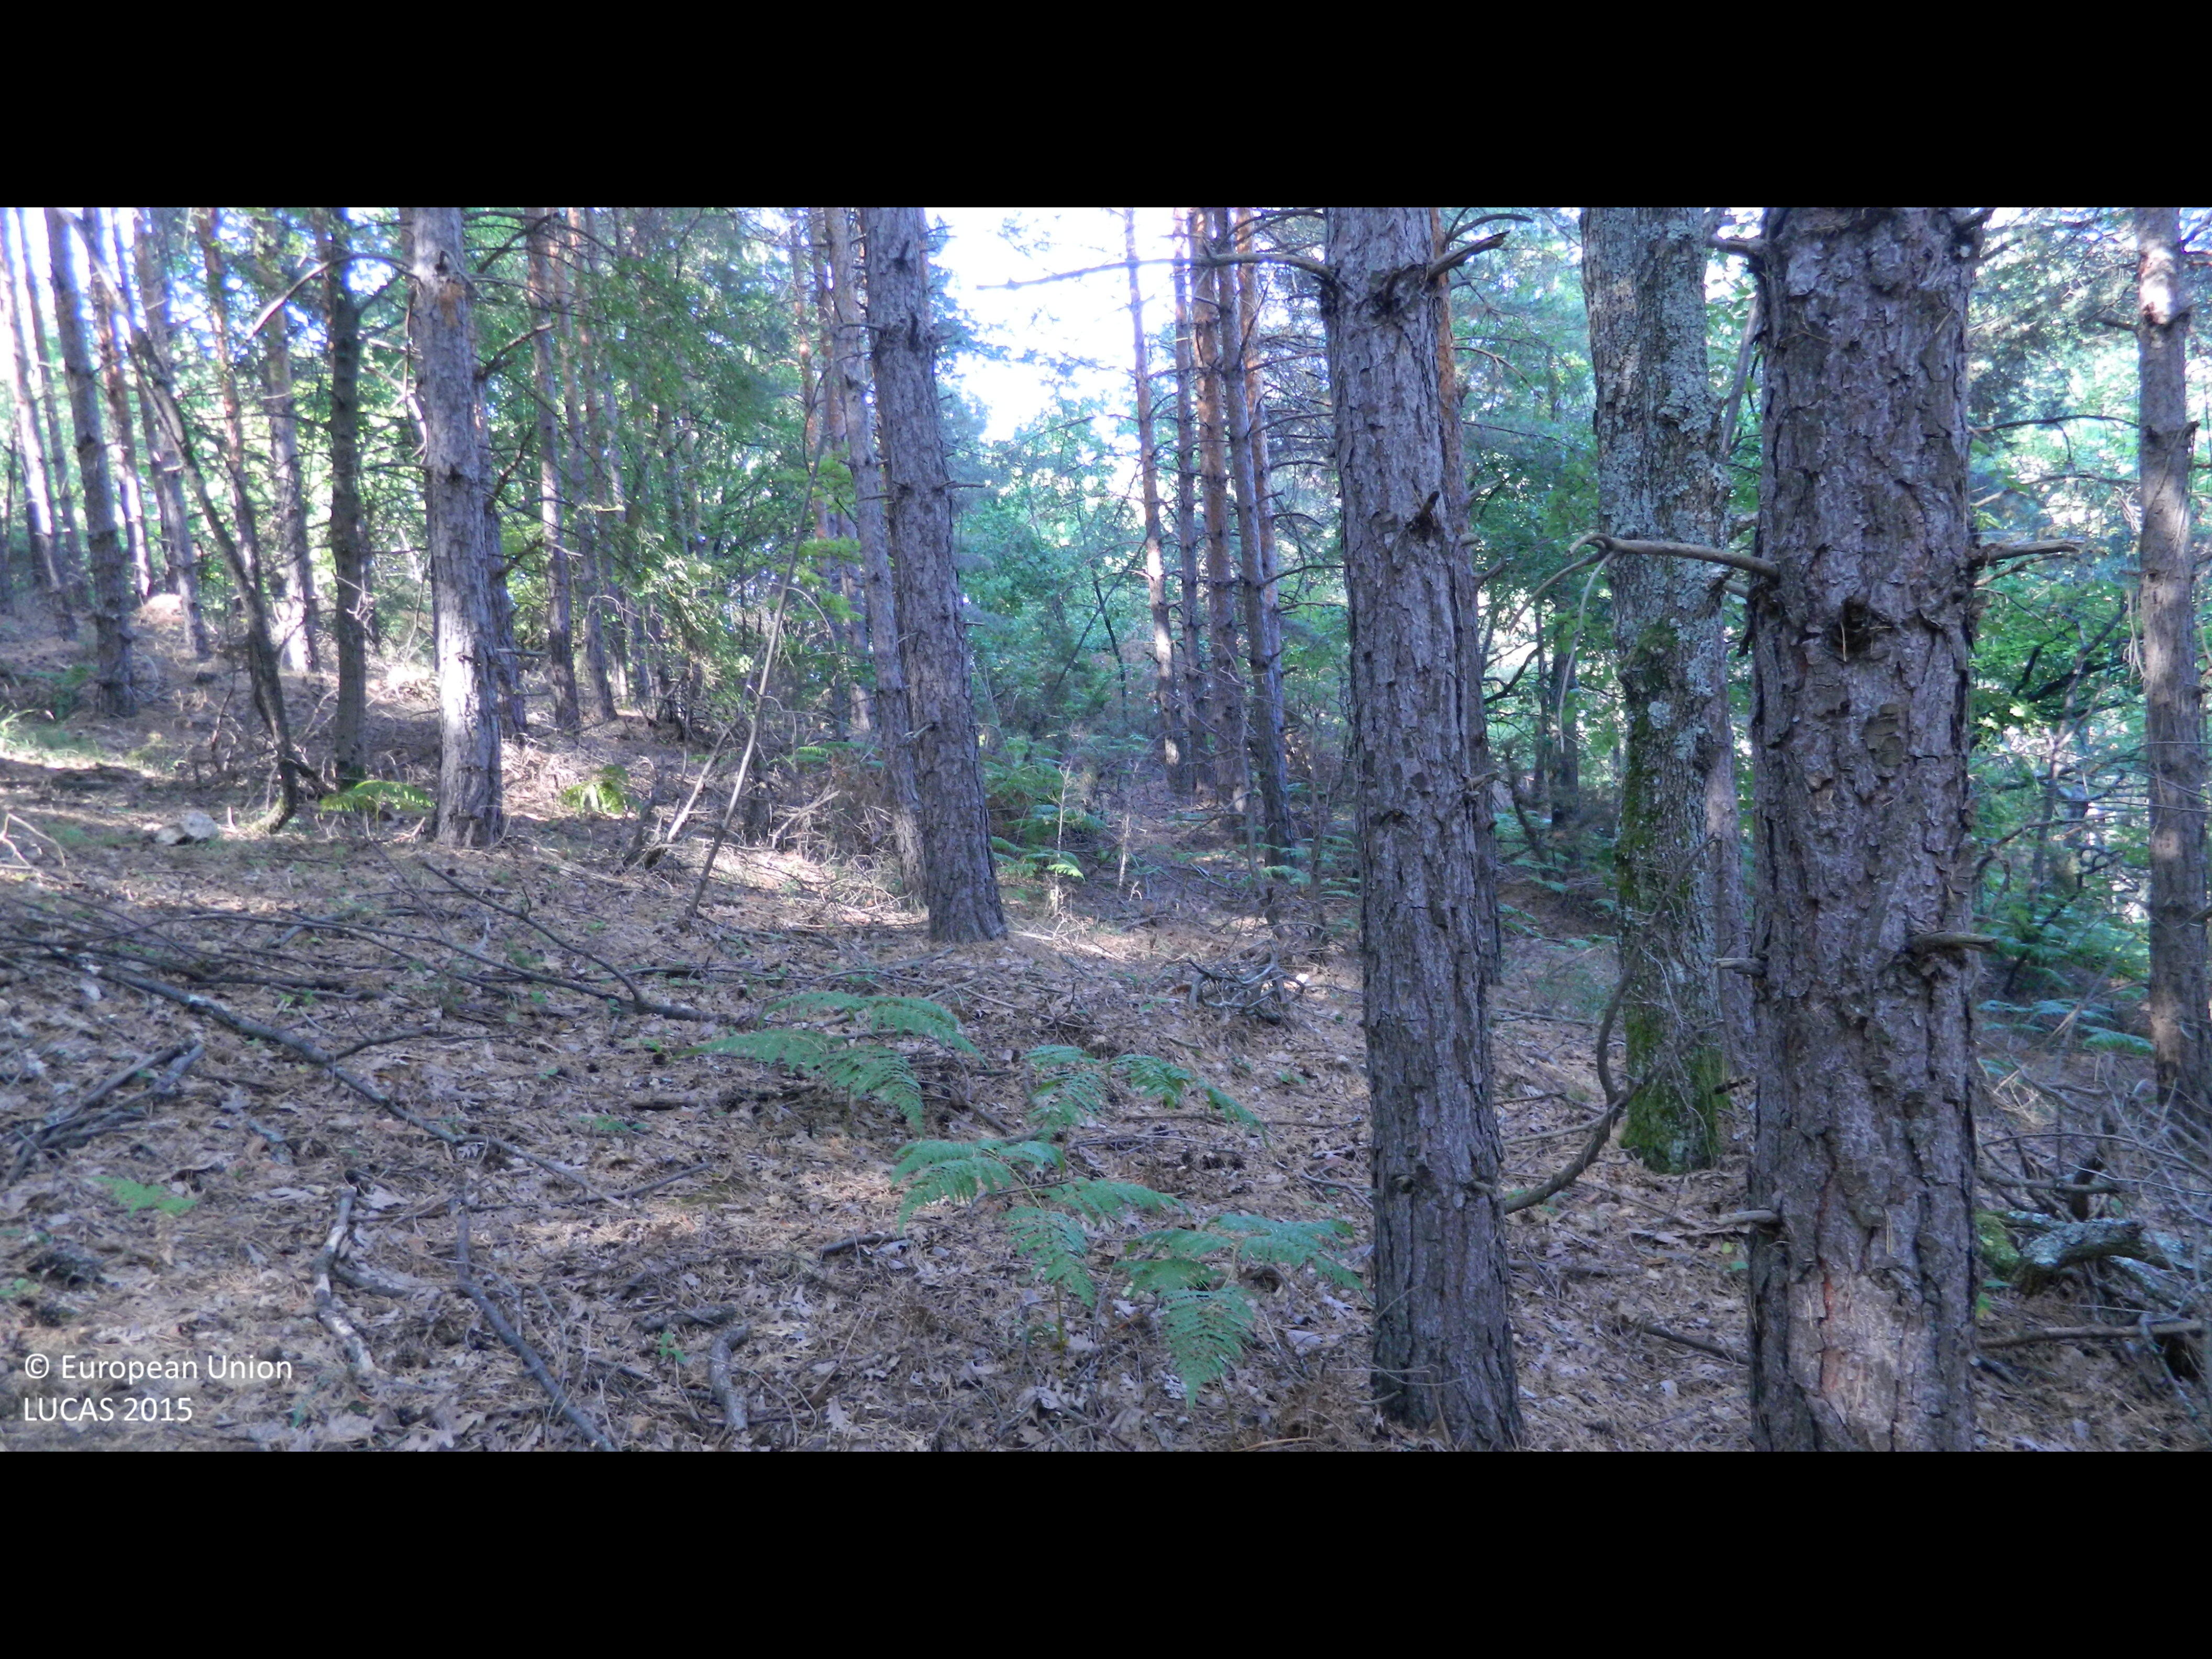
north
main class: Woodland
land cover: Pine dominated mixed woodland
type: hemiboreal forest and nemoral coniferous forest and mixed broadleaved-coniferous forest
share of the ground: > 75 %
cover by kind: coniferous forest trees 75 %, broadleaved forest trees 25 %
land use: Forestry
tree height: > 5 m
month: August
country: BG
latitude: 41.5571
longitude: 25.8808
